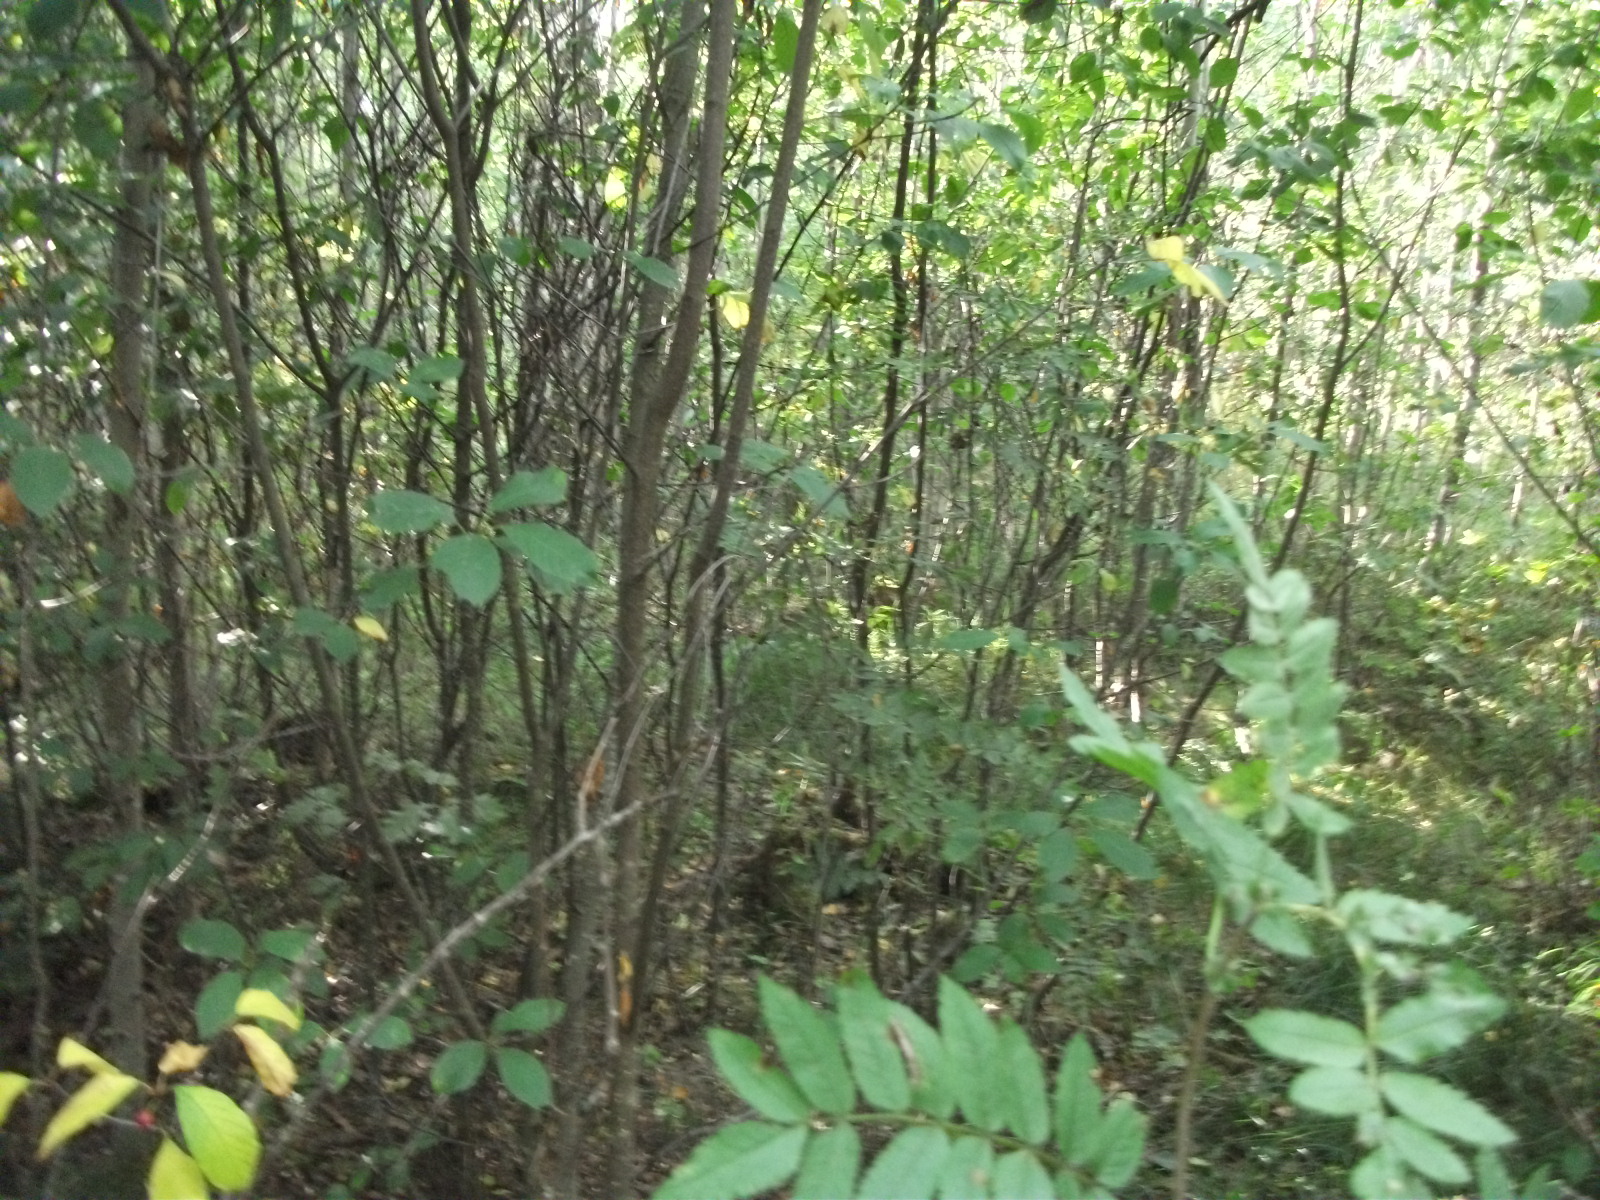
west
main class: Woodland
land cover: Broadleaved woodland
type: non-riverine alder, birch or aspen forest
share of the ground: > 75 %
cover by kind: broadleaved forest trees 90 %, shrubs 10 %
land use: Forestry
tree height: > 5 m
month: August
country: LV
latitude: 56.3827
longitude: 26.3224
